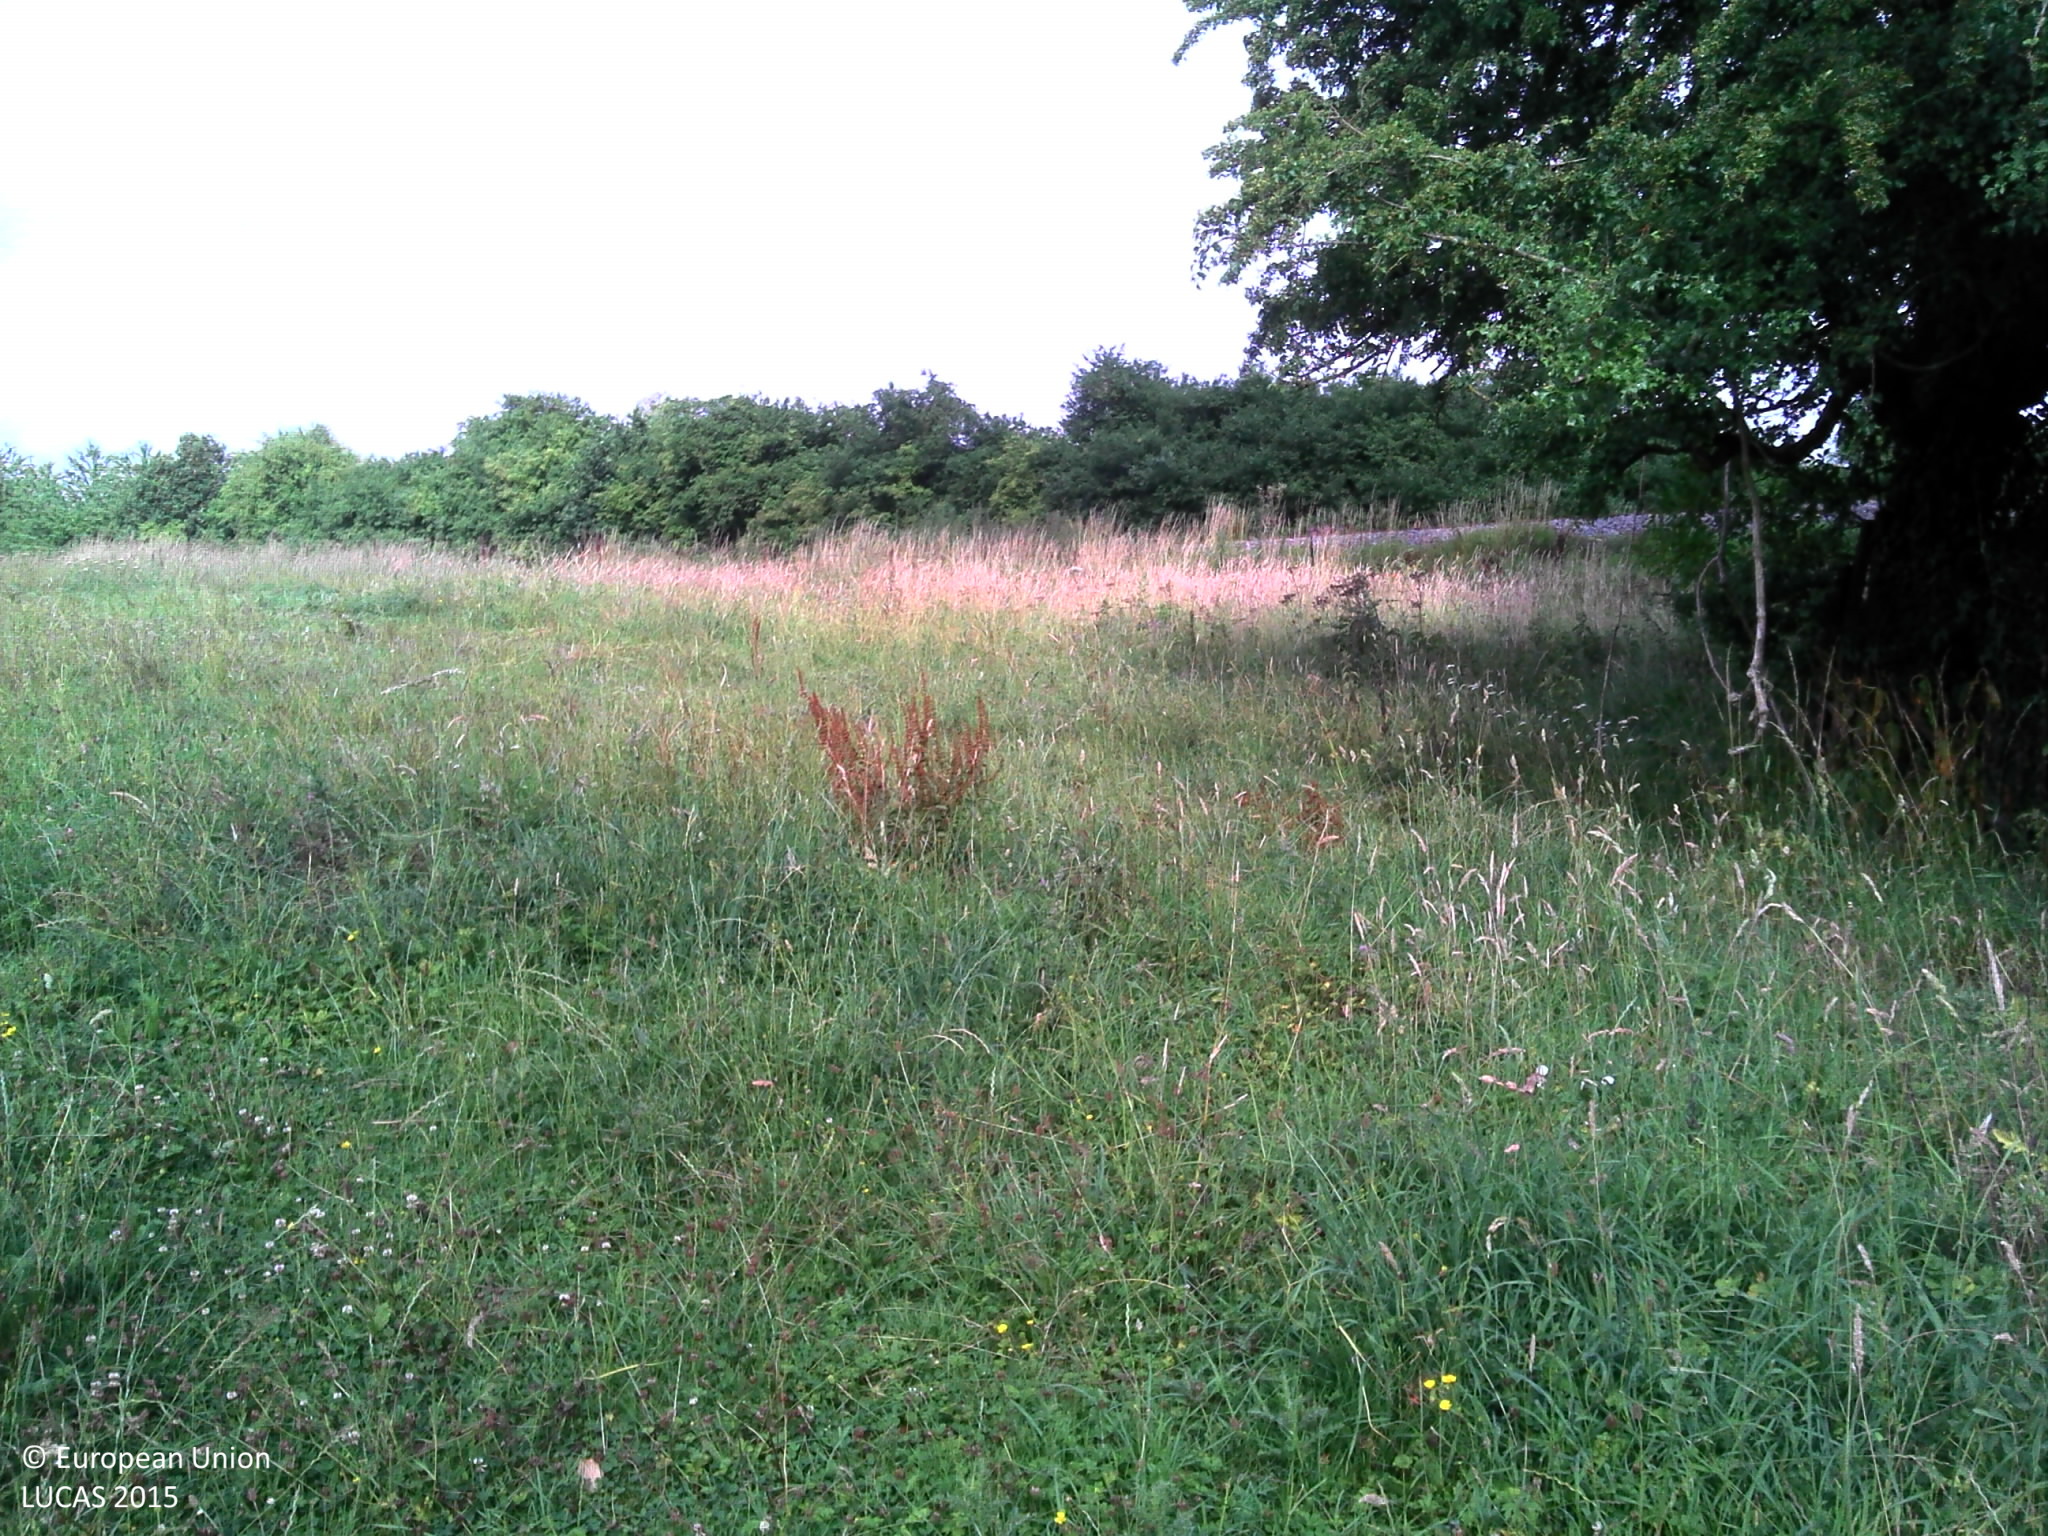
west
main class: Grassland
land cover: Grassland without tree/shrub cover
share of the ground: > 75 %
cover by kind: herbaceous plants 100 %
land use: Agriculture (excluding fallow land and kitchen gardens)
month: July
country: BE
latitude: 50.1787
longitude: 4.5207
